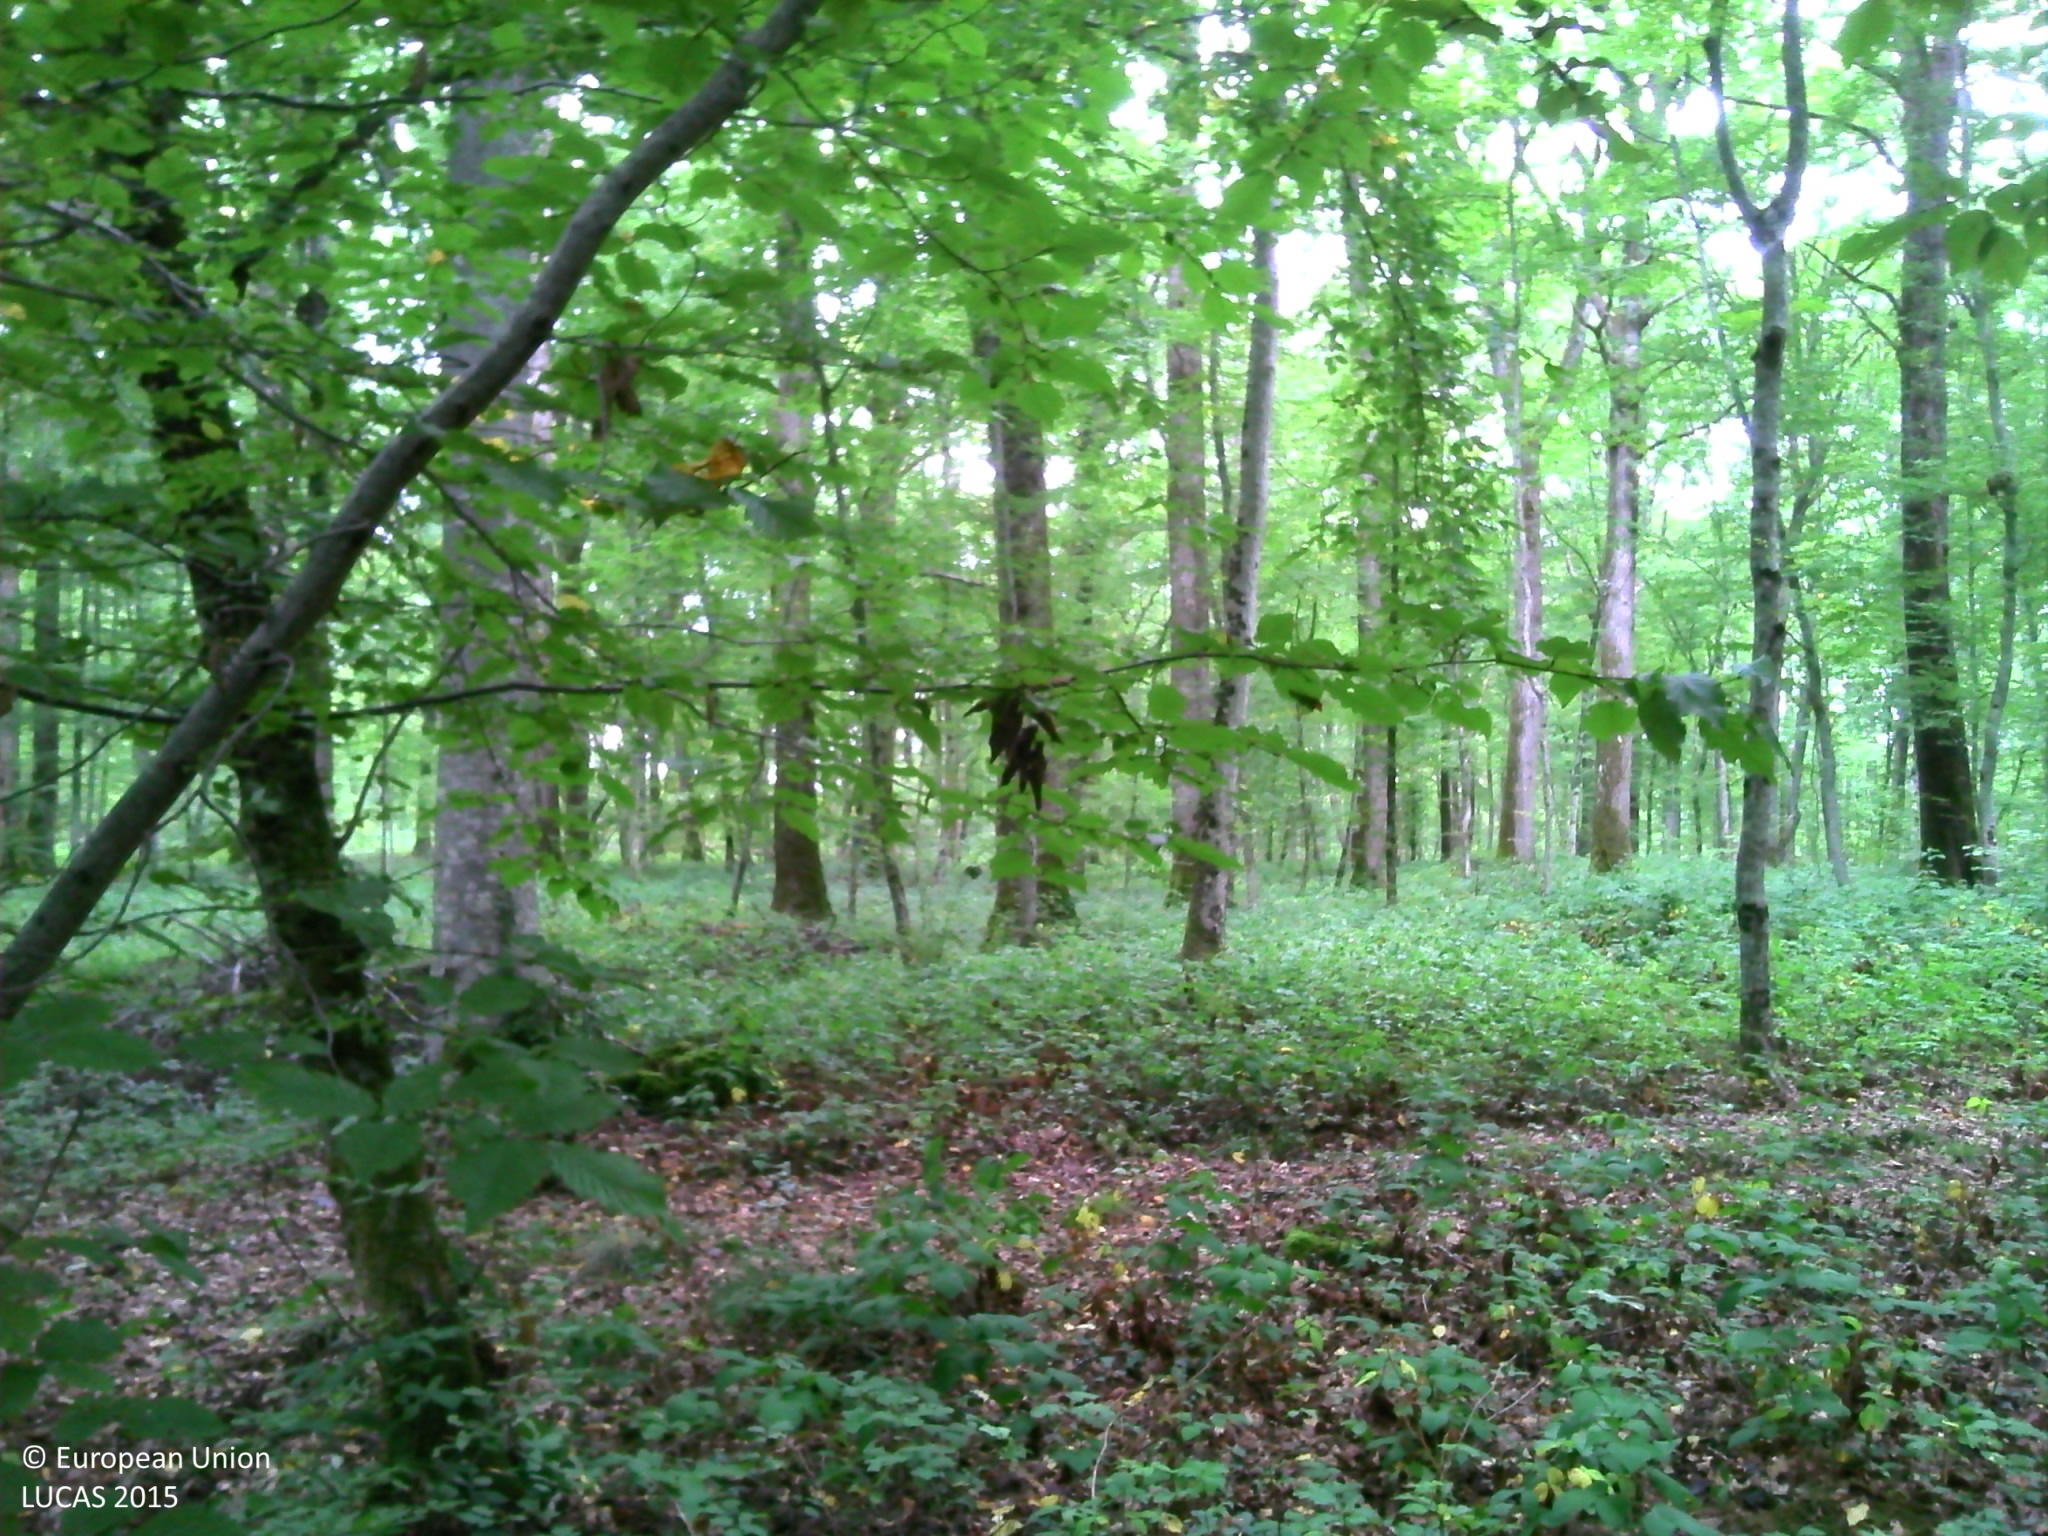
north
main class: Woodland
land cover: Broadleaved woodland
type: mesophytic deciduous forest
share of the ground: > 75 %
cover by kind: broadleaved forest trees 100 %
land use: Forestry
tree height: > 5 m
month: September
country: FR
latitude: 47.1621
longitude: 4.4198
